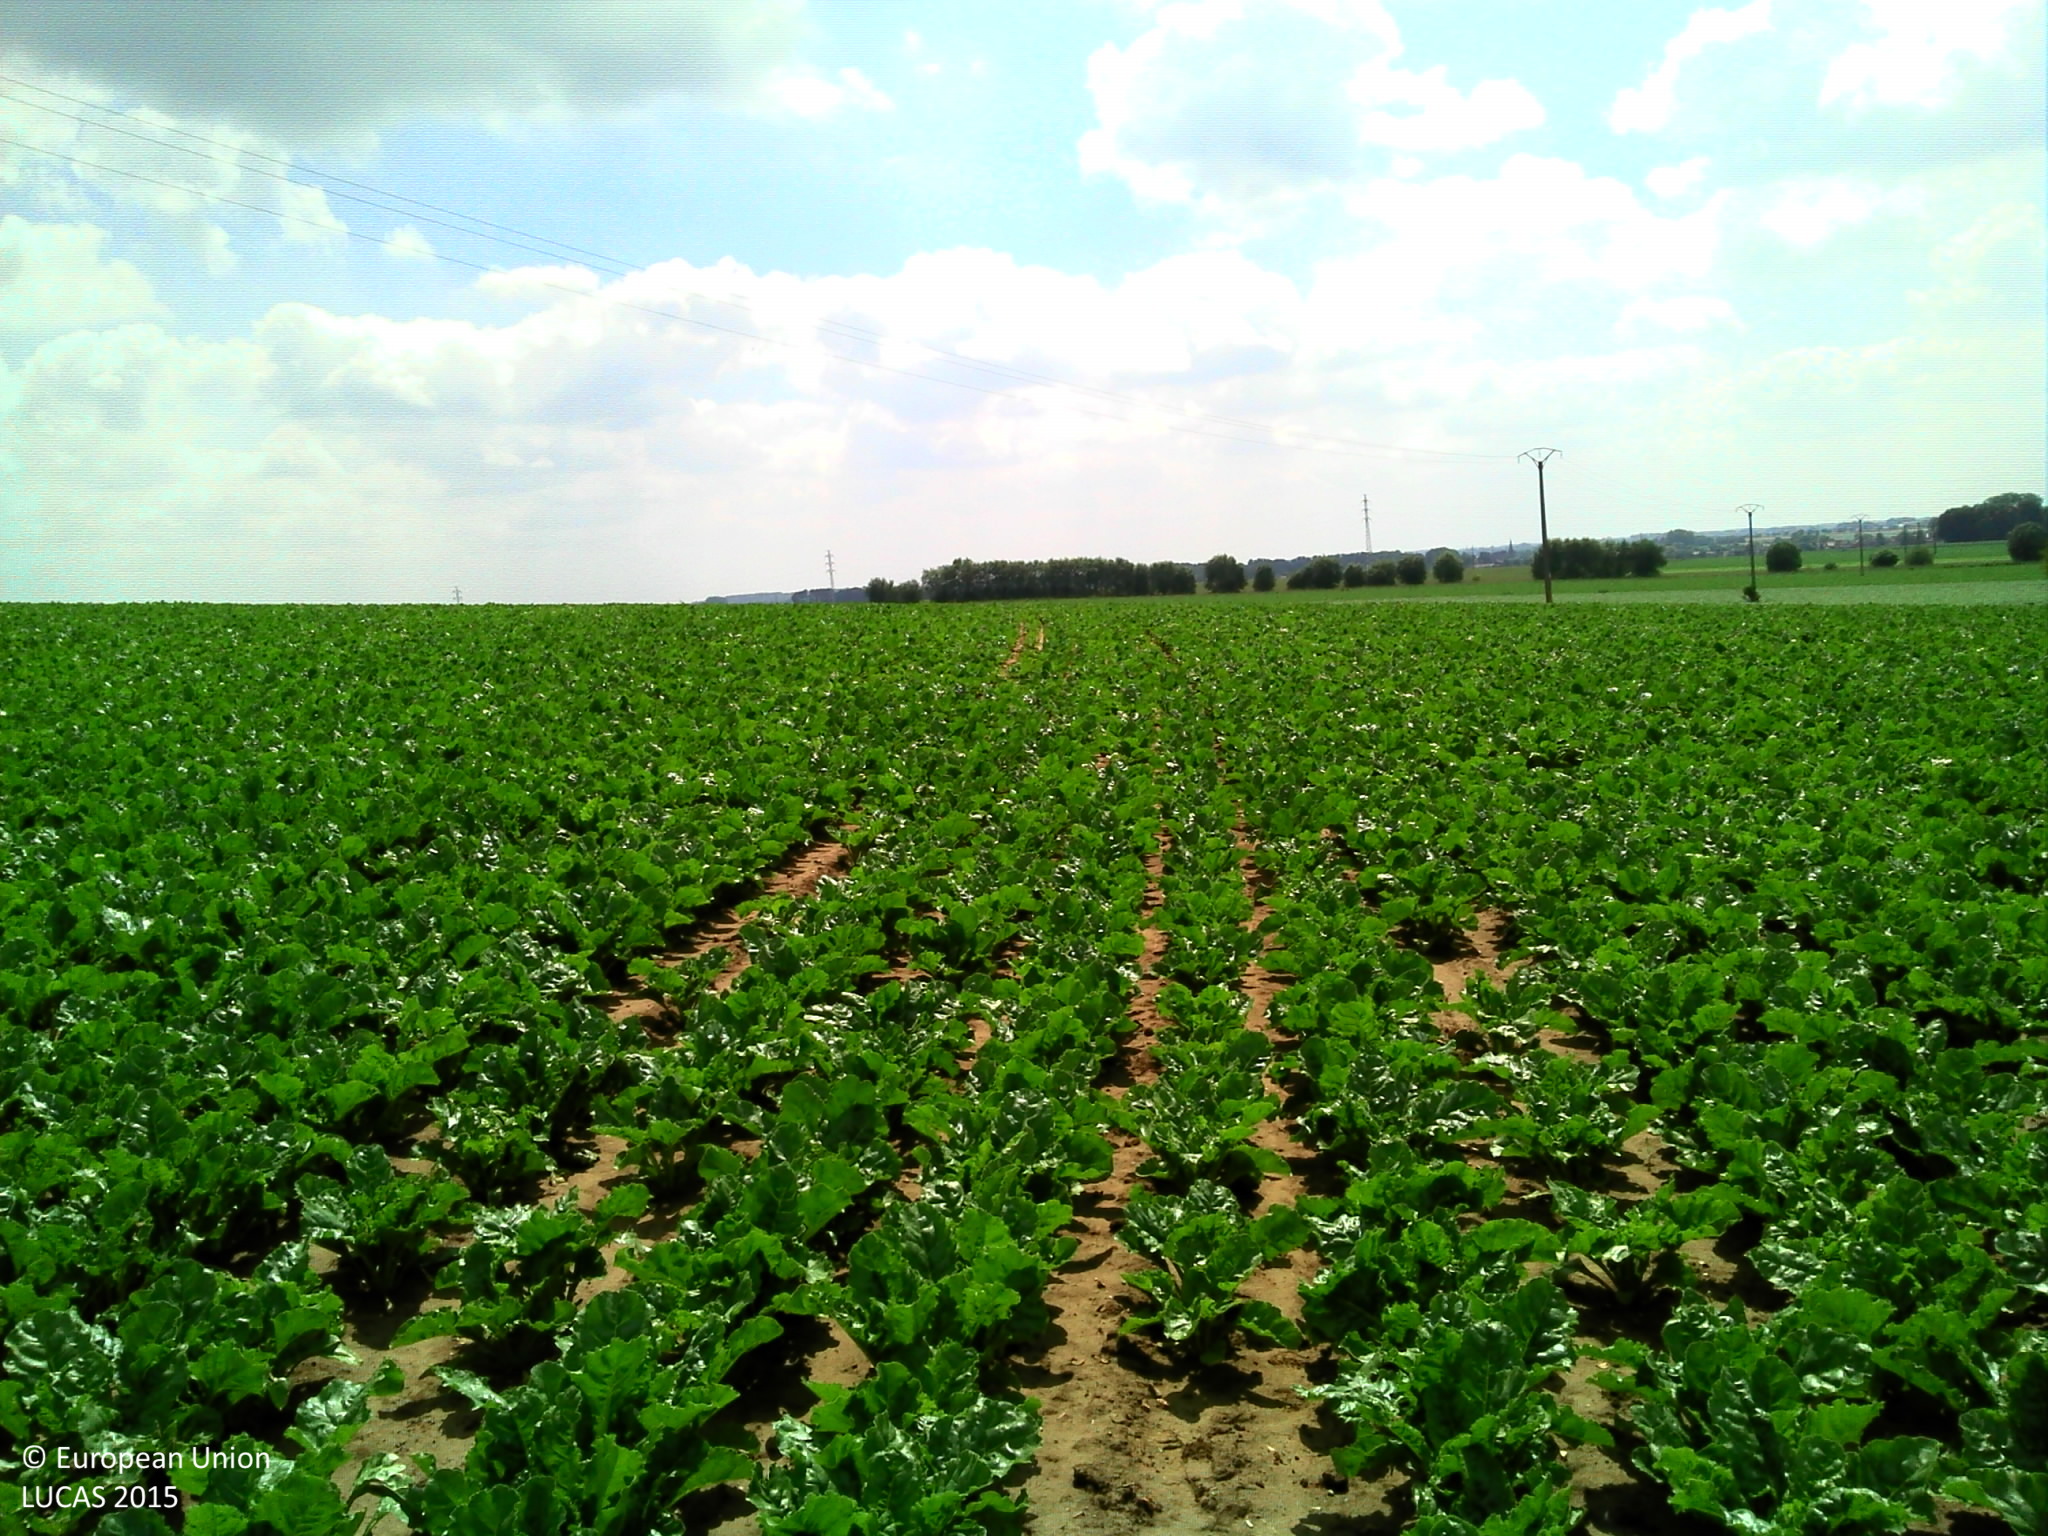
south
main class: Cropland
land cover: Sugar beet
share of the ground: 50 - 75 %
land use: Agriculture (excluding fallow land and kitchen gardens)
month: June
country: BE
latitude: 50.6146
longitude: 3.8743
